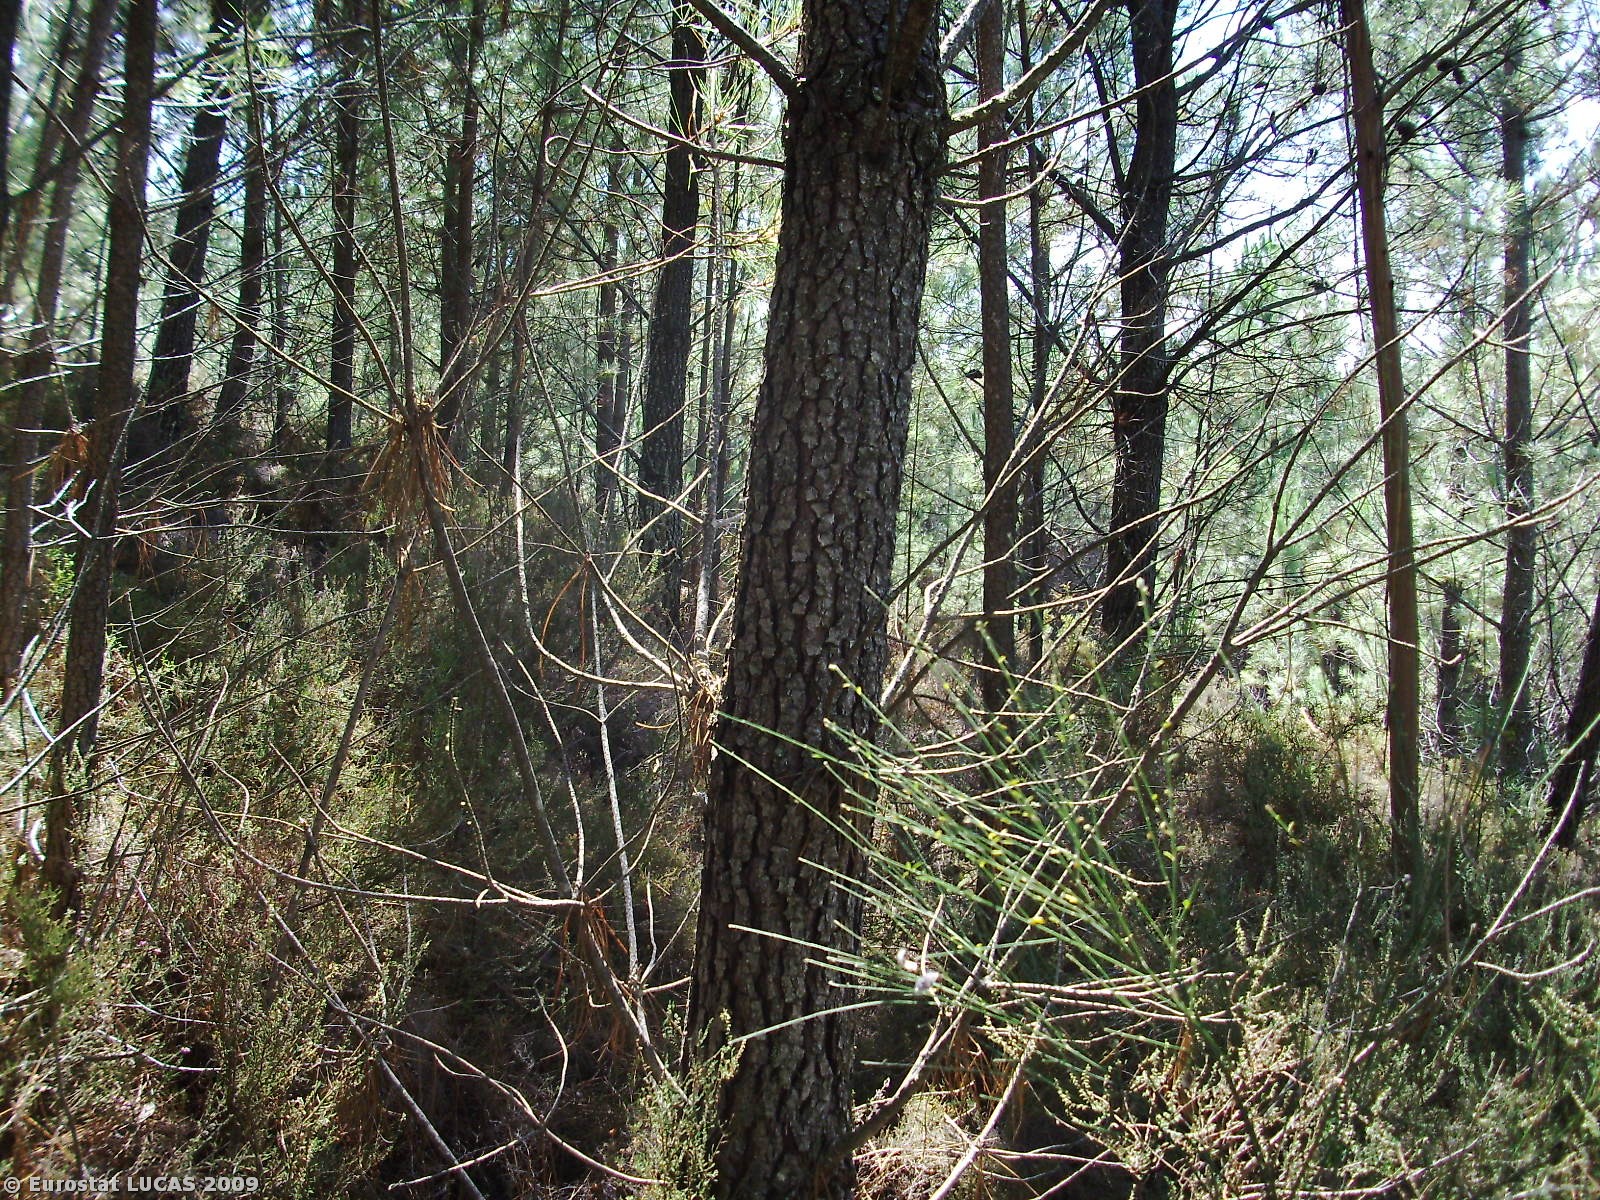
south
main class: Woodland
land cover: Coniferous woodland
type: coniferous forest of the mediterranean region
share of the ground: > 75 %
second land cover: Shrubland with sparse tree cover
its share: 10 - 25 %
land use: Forestry
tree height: > 5 m
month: August
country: PT
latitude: 40.0318
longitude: -8.1789
